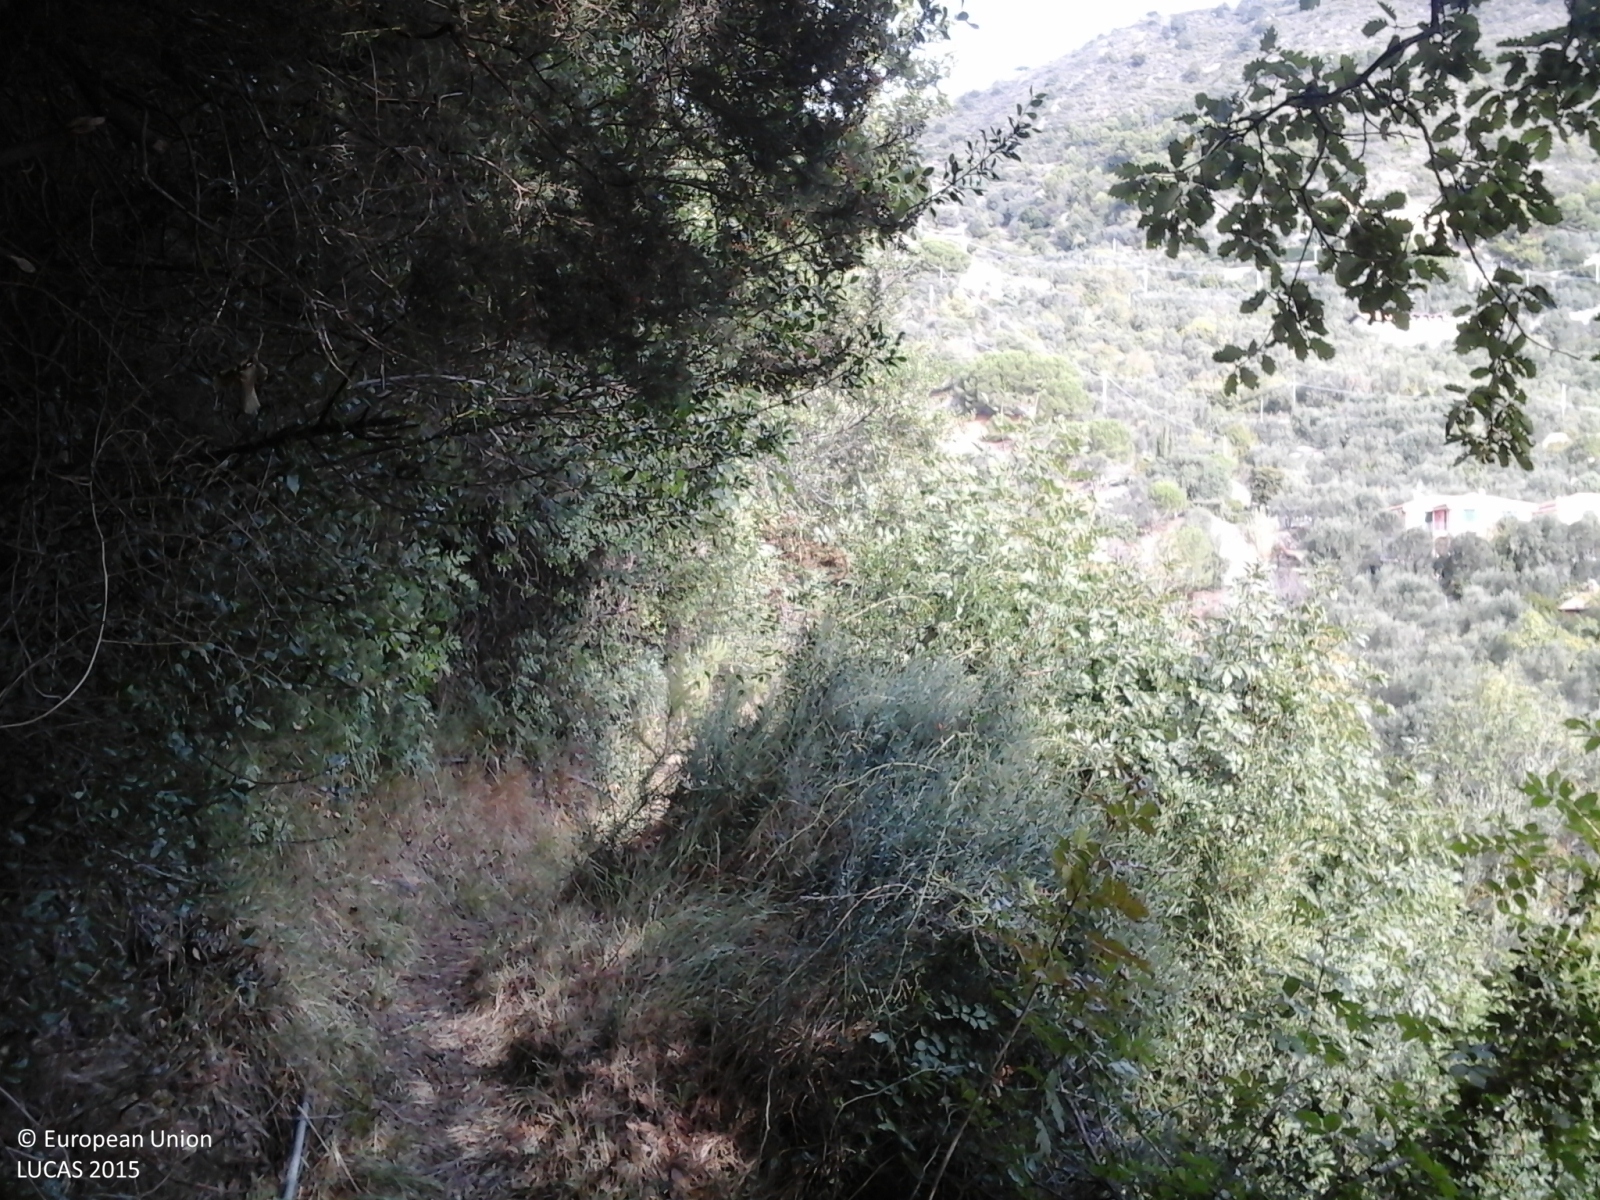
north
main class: Woodland
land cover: Other mixed woodland
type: broadleaved evergreen forest
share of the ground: > 75 %
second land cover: Shrubland without tree cover
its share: 10 - 25 %
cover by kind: broadleaved forest trees 50 %, coniferous forest trees 20 %, shrubs 20 %, herbaceous plants 10 %
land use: Semi-natural and natural areas not in use
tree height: > 5 m
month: October
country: IT
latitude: 44.0092
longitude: 8.1460
